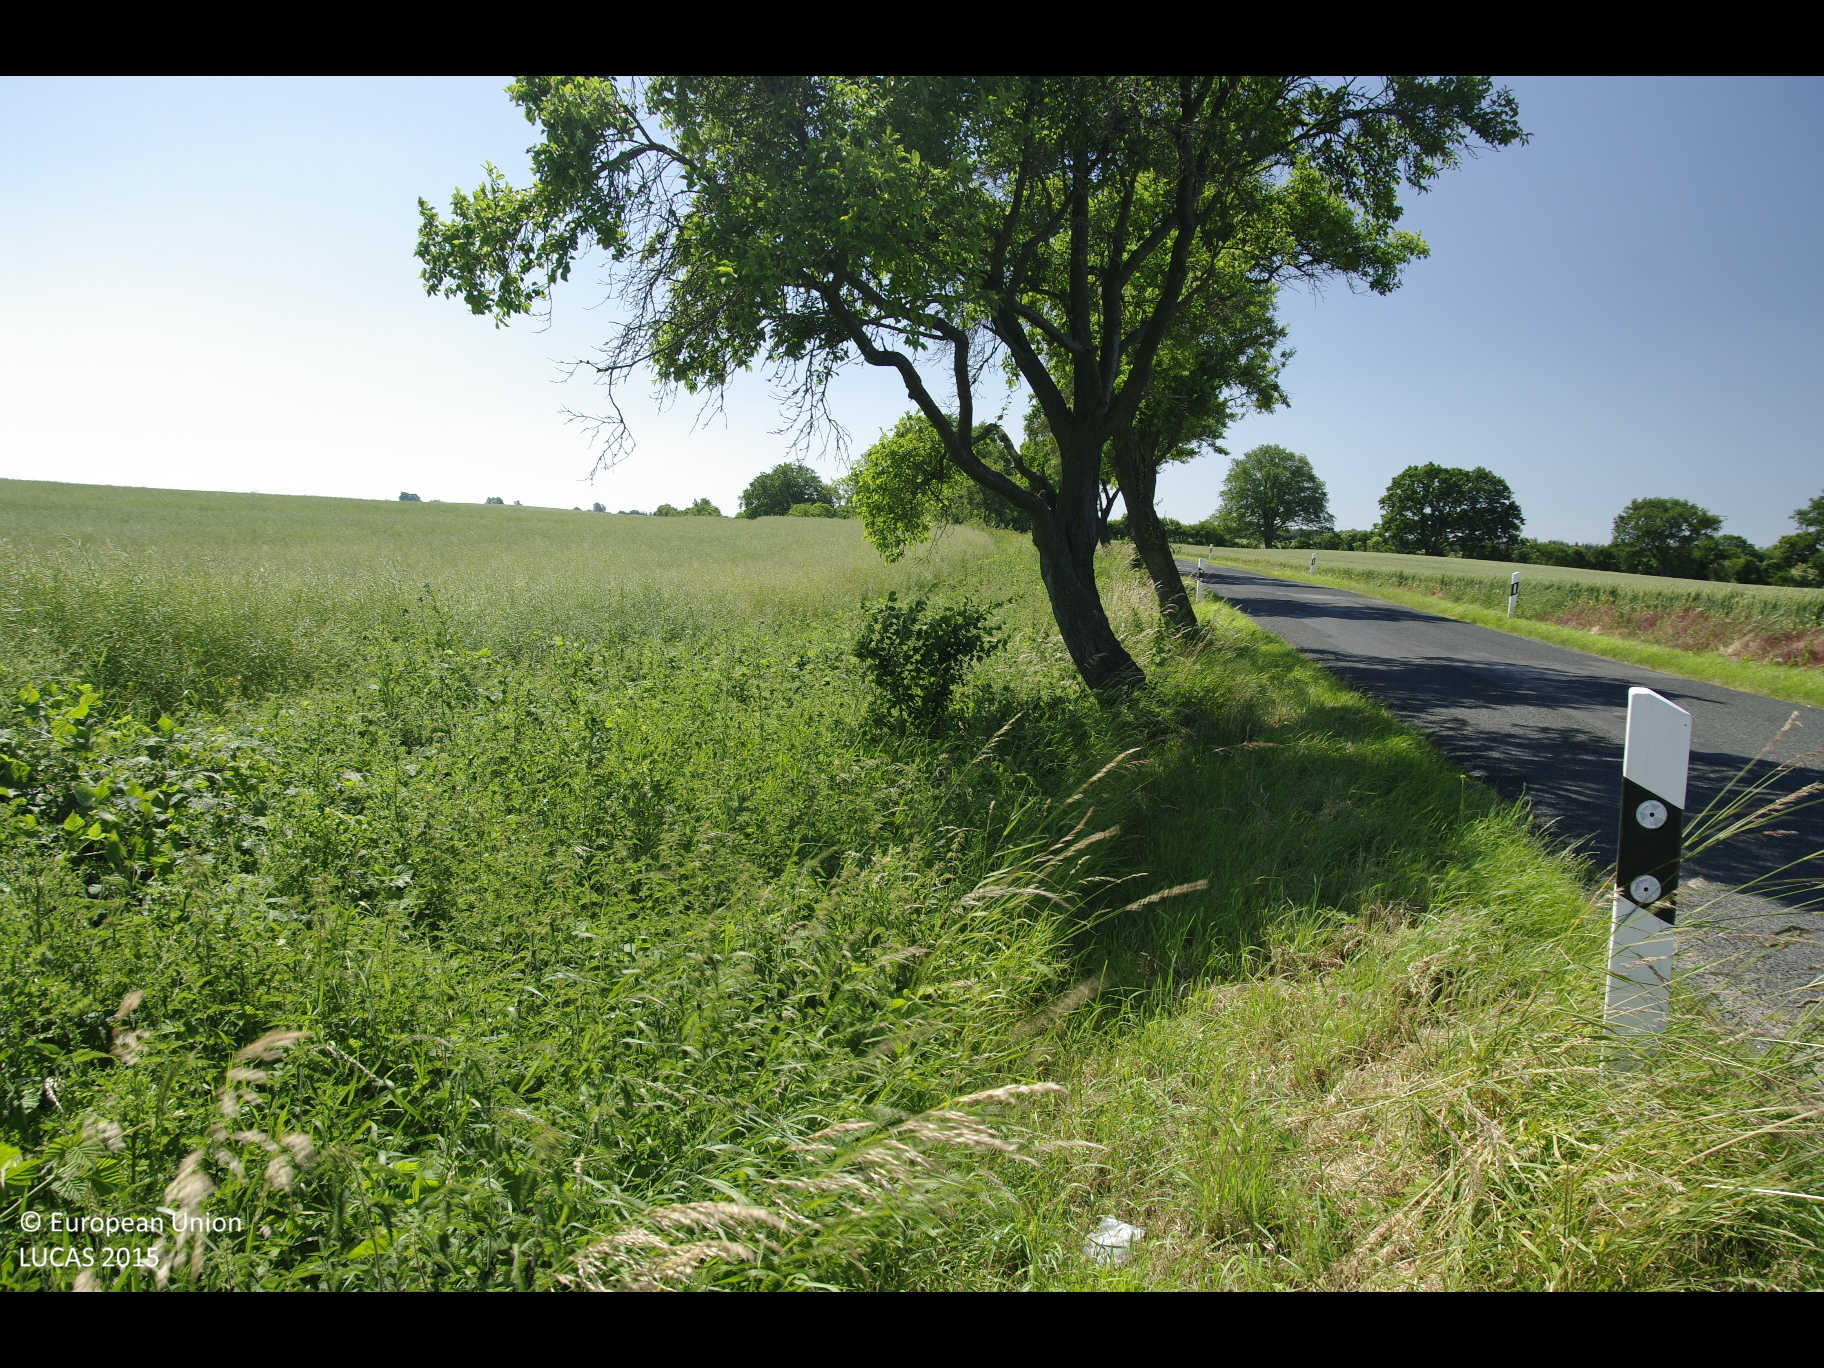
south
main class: Cropland
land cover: Rape and turnip rape
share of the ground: > 75 %
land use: Agriculture (excluding fallow land and kitchen gardens)
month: July
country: DE
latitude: 53.7574
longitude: 10.9854
